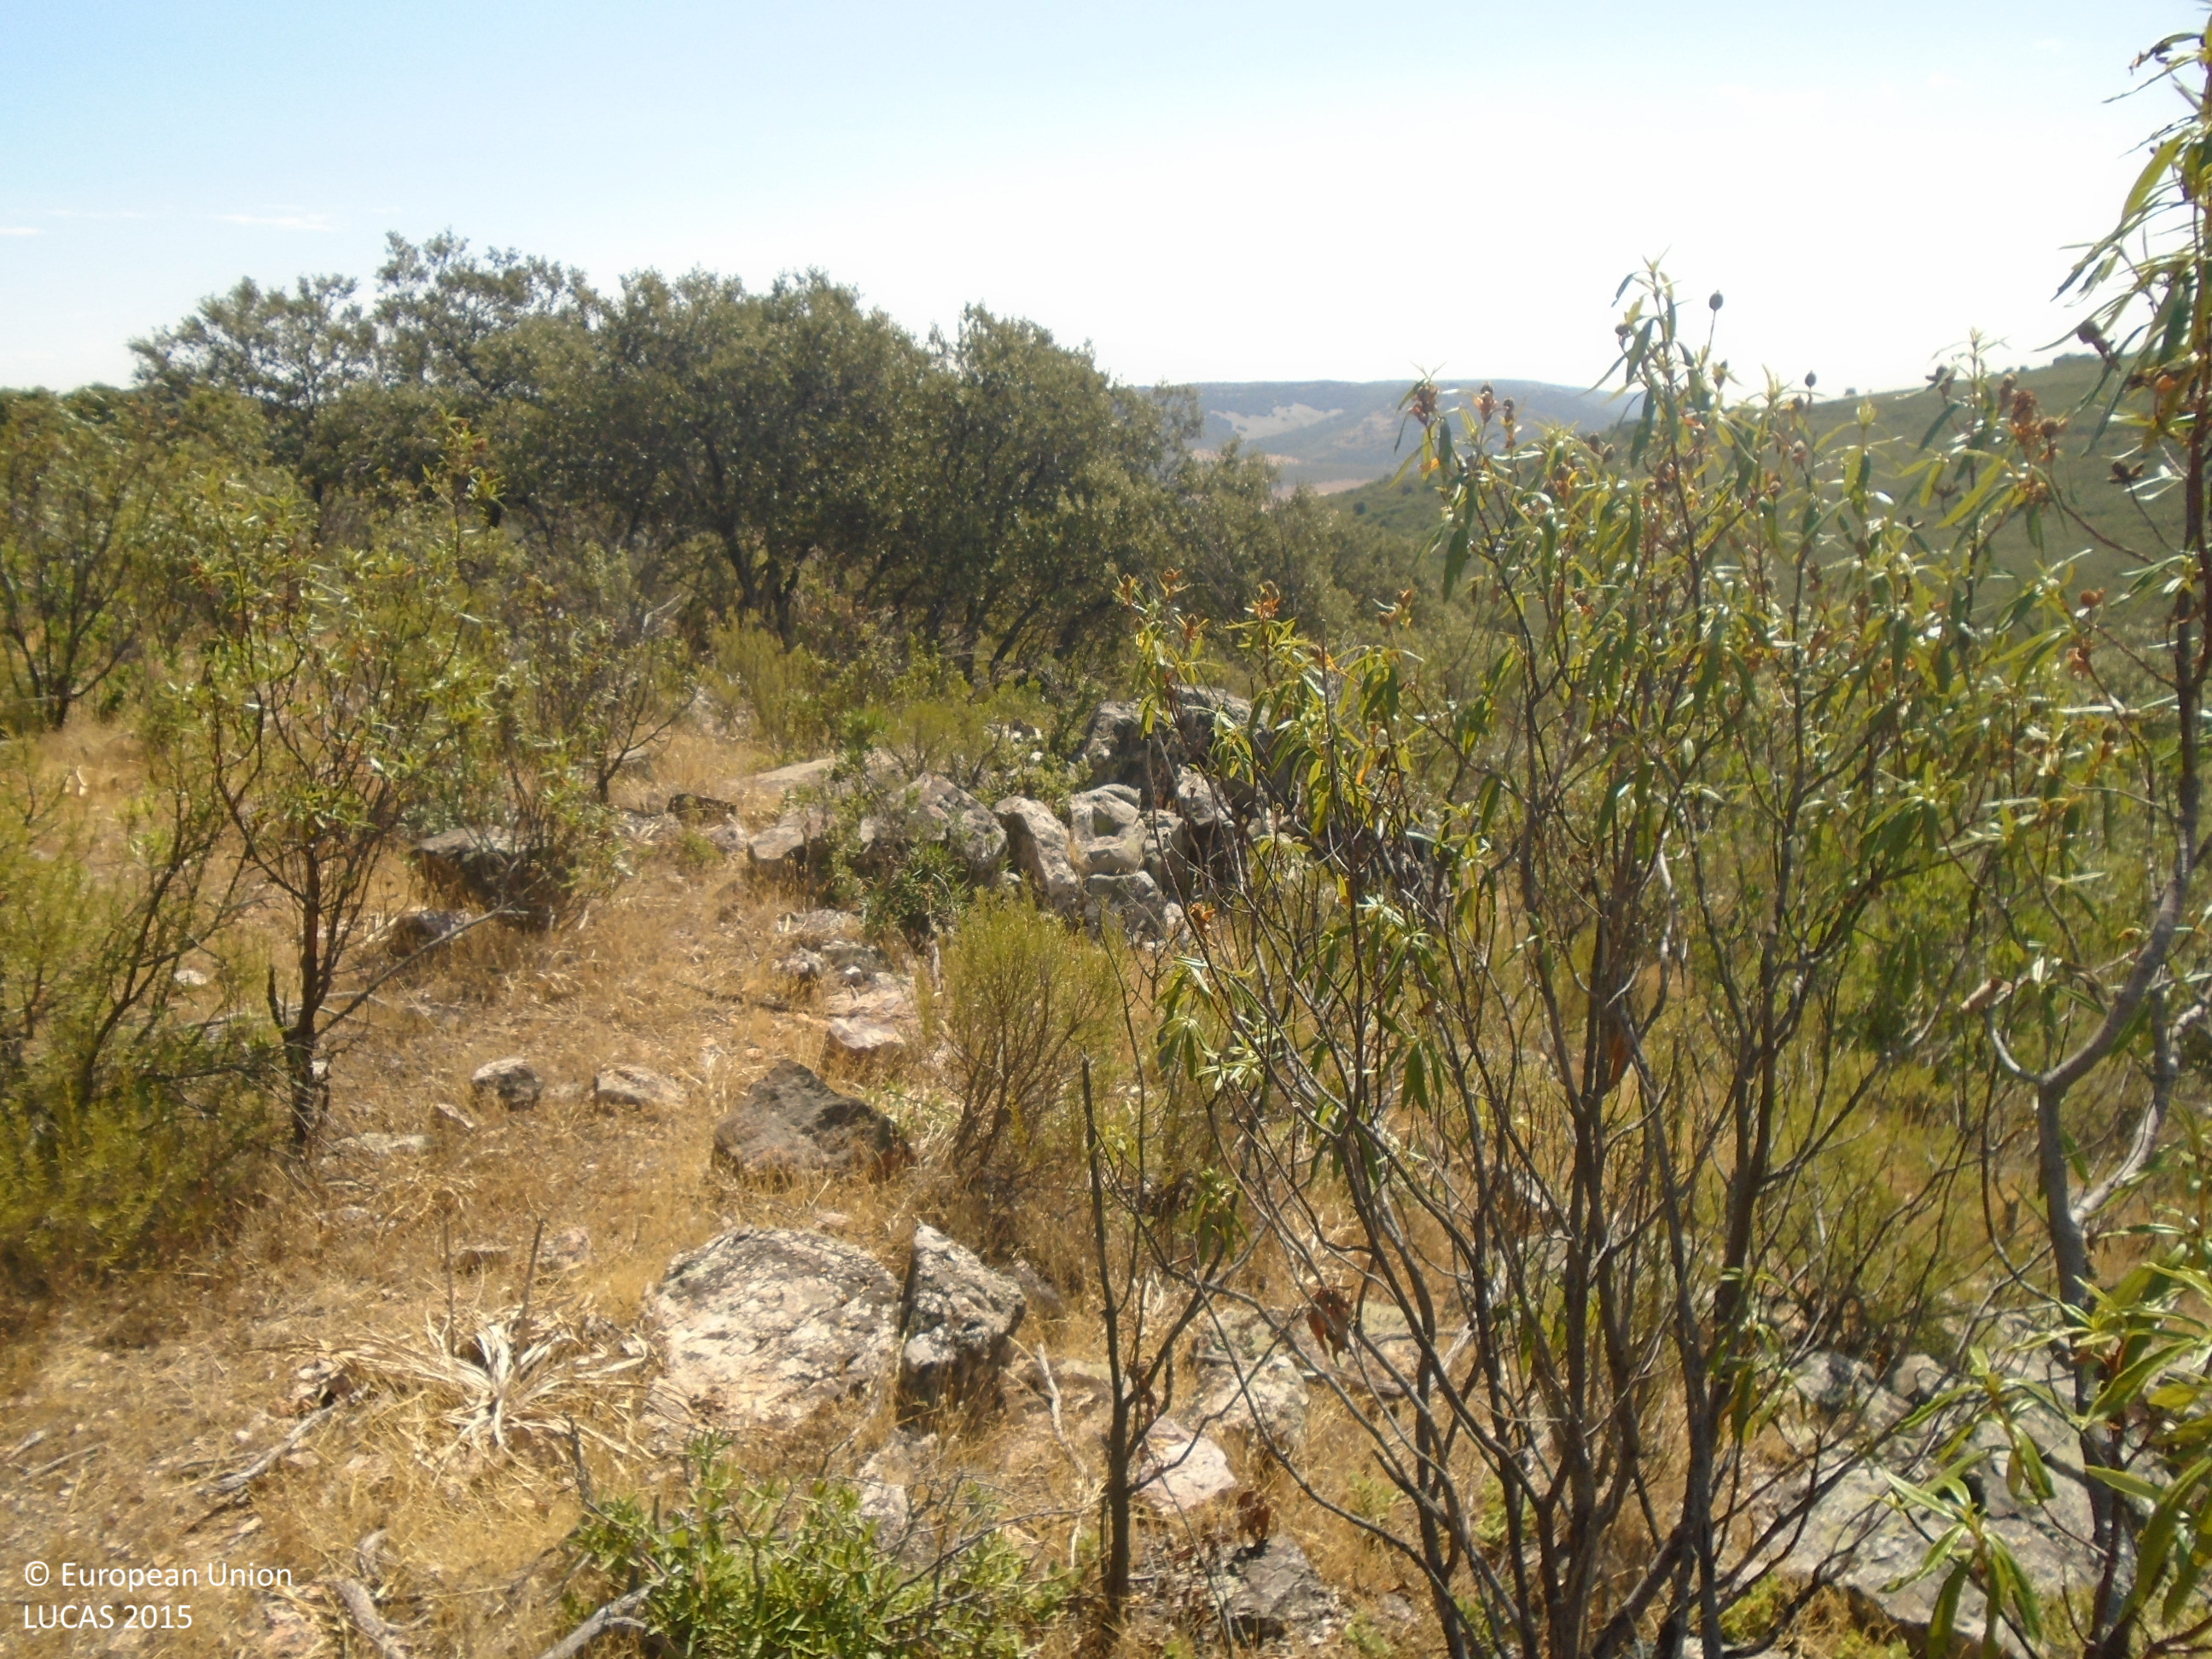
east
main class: Shrubland
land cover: Shrubland without tree cover
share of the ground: > 75 %
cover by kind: shrubs 95 %, consolidated bare surface 5 %
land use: Semi-natural and natural areas not in use
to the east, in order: Shrubland without tree cover
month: July
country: ES
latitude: 39.2217
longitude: -4.1229
